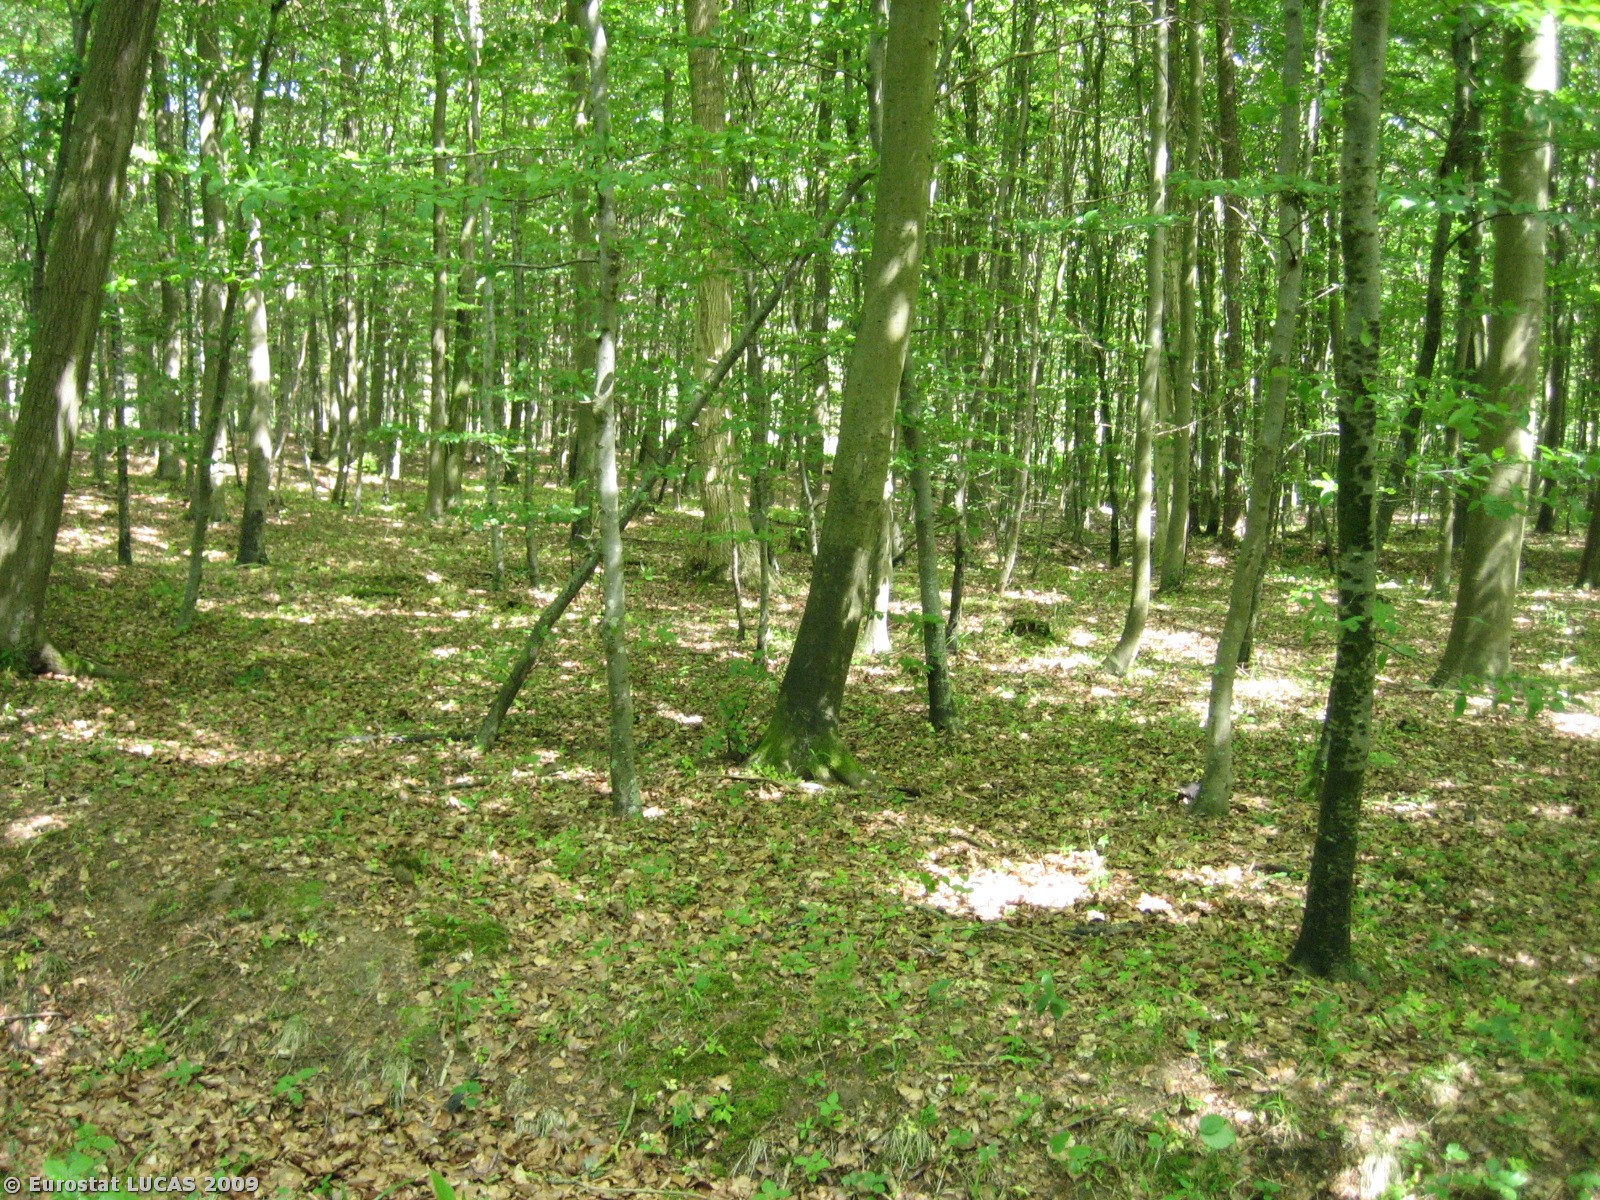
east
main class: Woodland
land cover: Broadleaved woodland
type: mesophytic deciduous forest
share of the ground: > 75 %
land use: Forestry
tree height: > 5 m
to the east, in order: Broadleaved woodland; Coniferous woodland; Broadleaved woodland; Coniferous woodland; Tracks; Broadleaved woodland; Fences; Broadleaved woodland
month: June
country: DK
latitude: 55.6844
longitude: 9.8570
